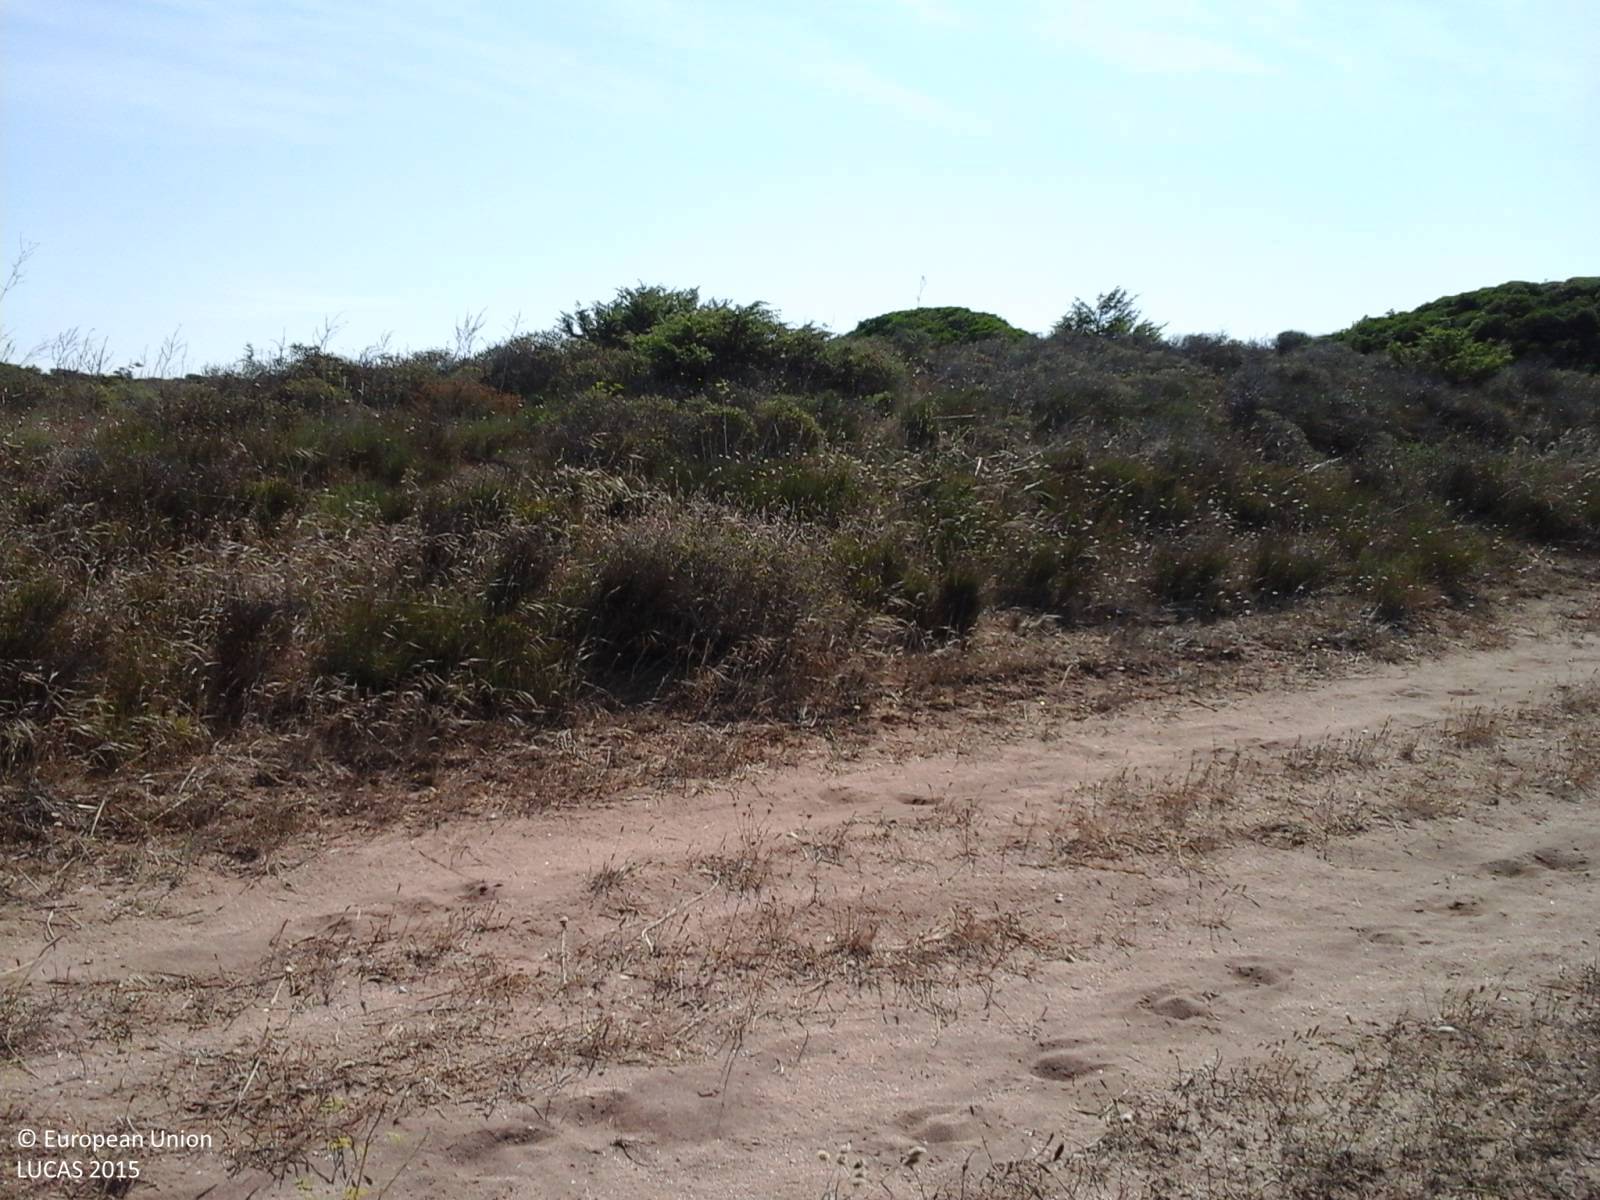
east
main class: Grassland
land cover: Spontaneously vegetated surfaces
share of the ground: > 75 %
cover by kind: herbaceous plants 100 %
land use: Semi-natural and natural areas not in use
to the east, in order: Spontaneously vegetated surfaces; Tracks; Grass margins; Tracks; Fences; Shrubland without tree cover; Tracks; Shrubland without tree cover
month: August
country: IT
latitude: 40.0385
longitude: 8.4963
